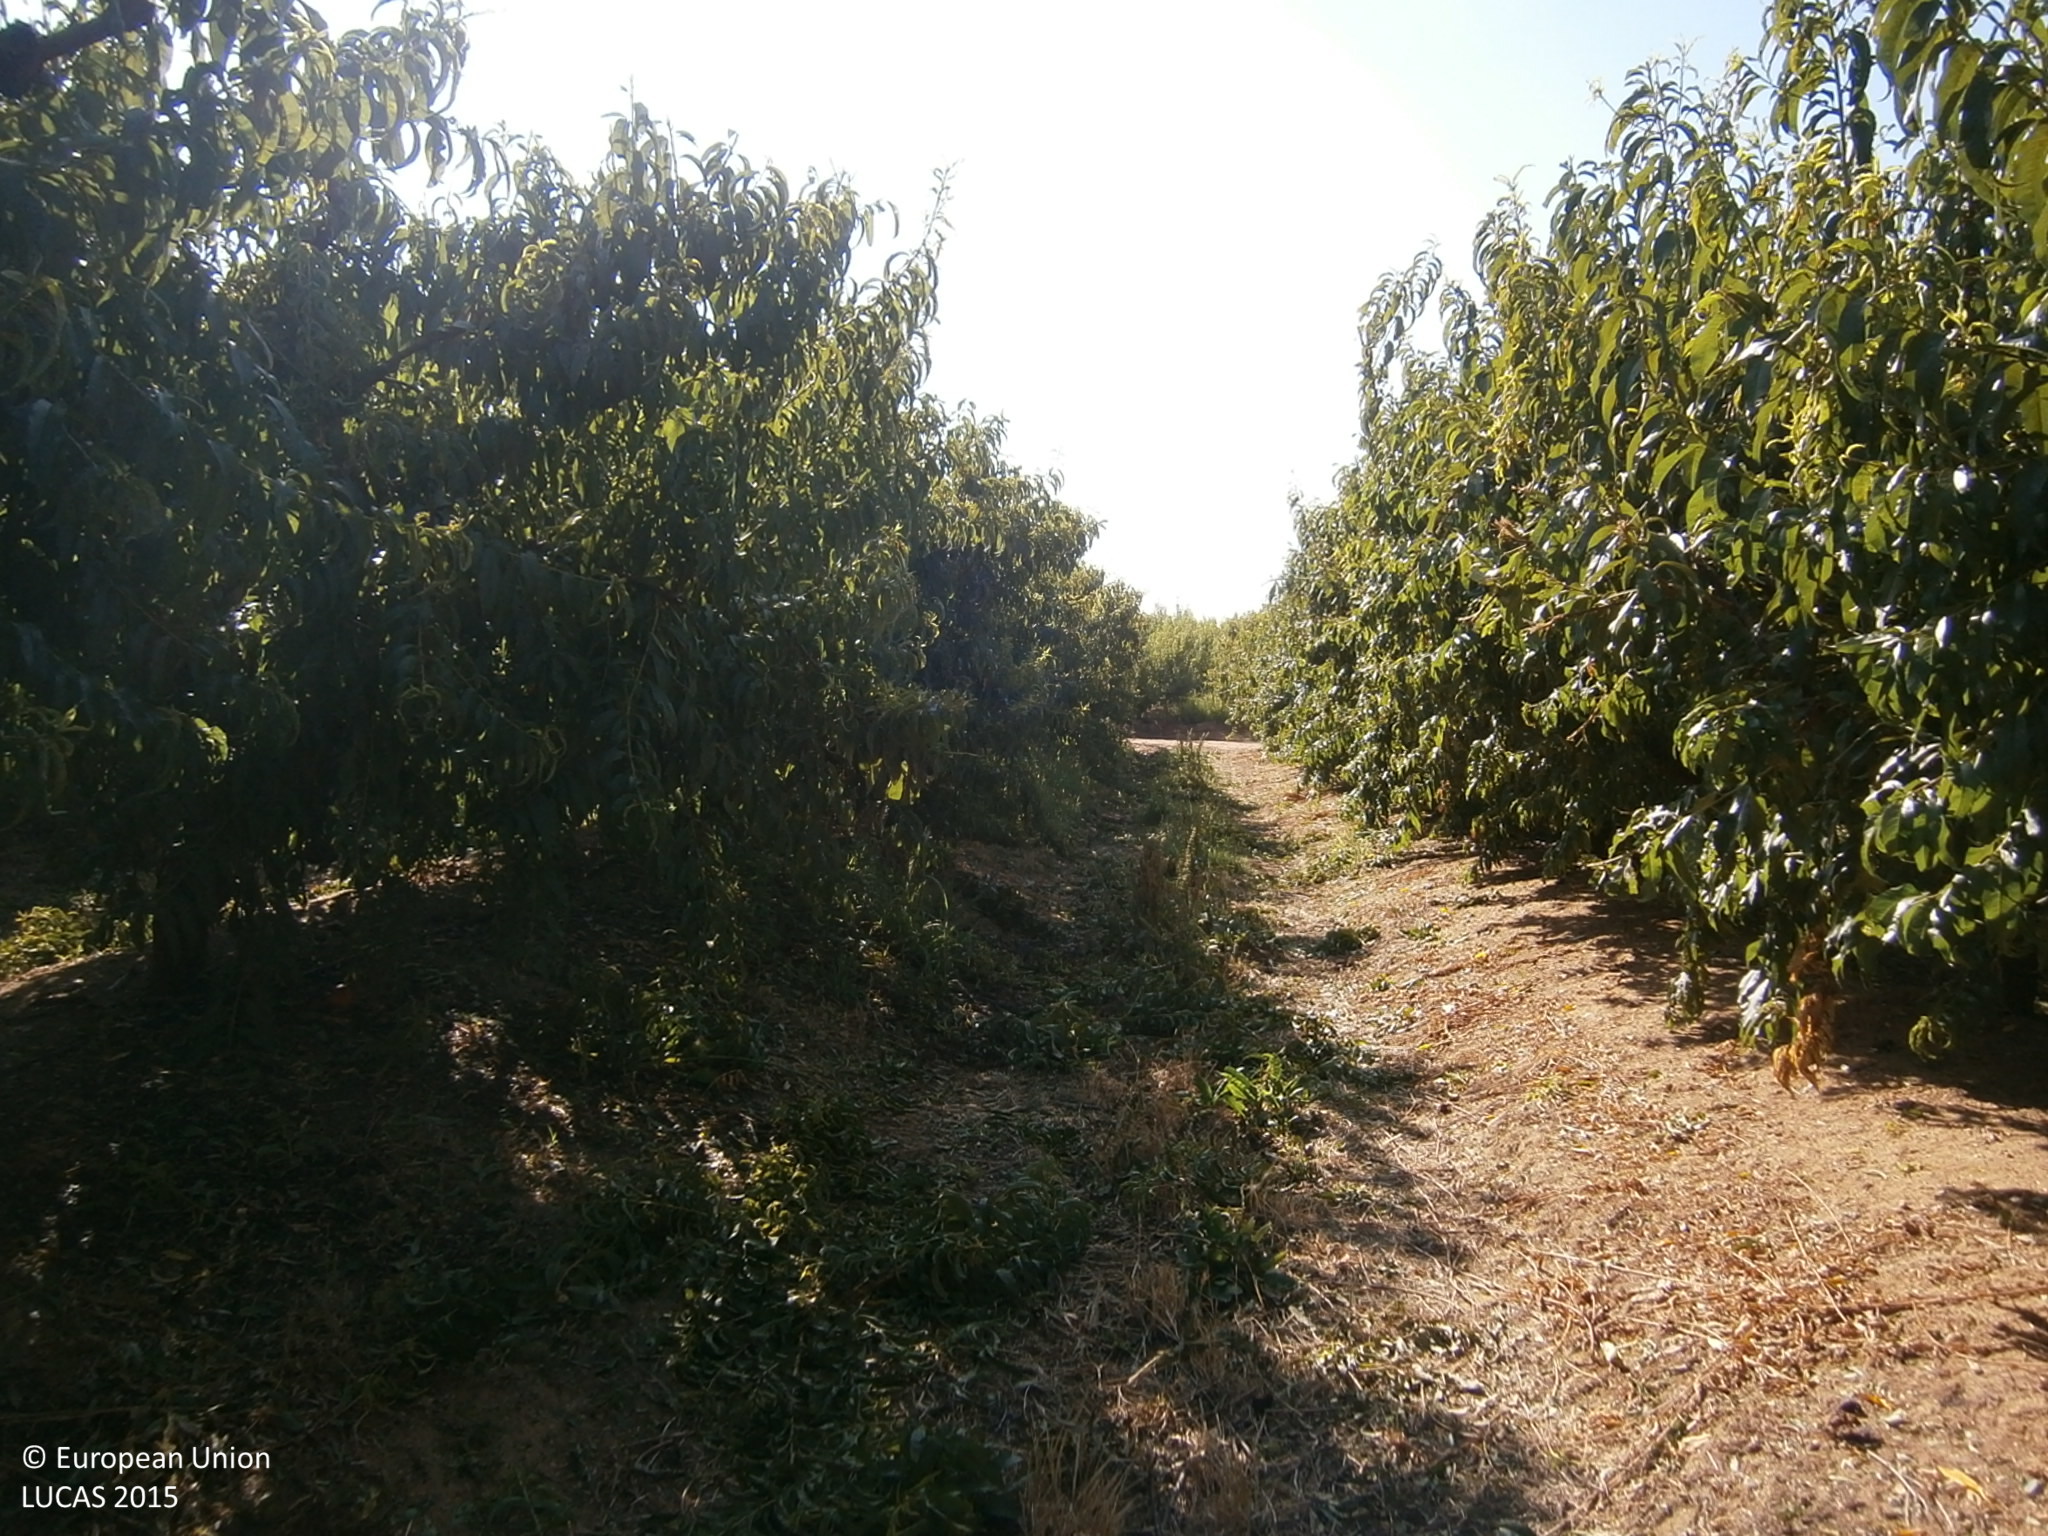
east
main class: Cropland
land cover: Other fruit trees and berries
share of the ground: 25 - 50 %
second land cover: Spontaneously vegetated surfaces
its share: 25 - 50 %
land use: Agriculture (excluding fallow land and kitchen gardens)
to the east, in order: Other fruit trees and berries; Spontaneously vegetated surfaces; Tracks; Other fruit trees and berries; Electric lines; Other fruit trees and berries
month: July
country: ES
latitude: 38.9326
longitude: -6.9235
